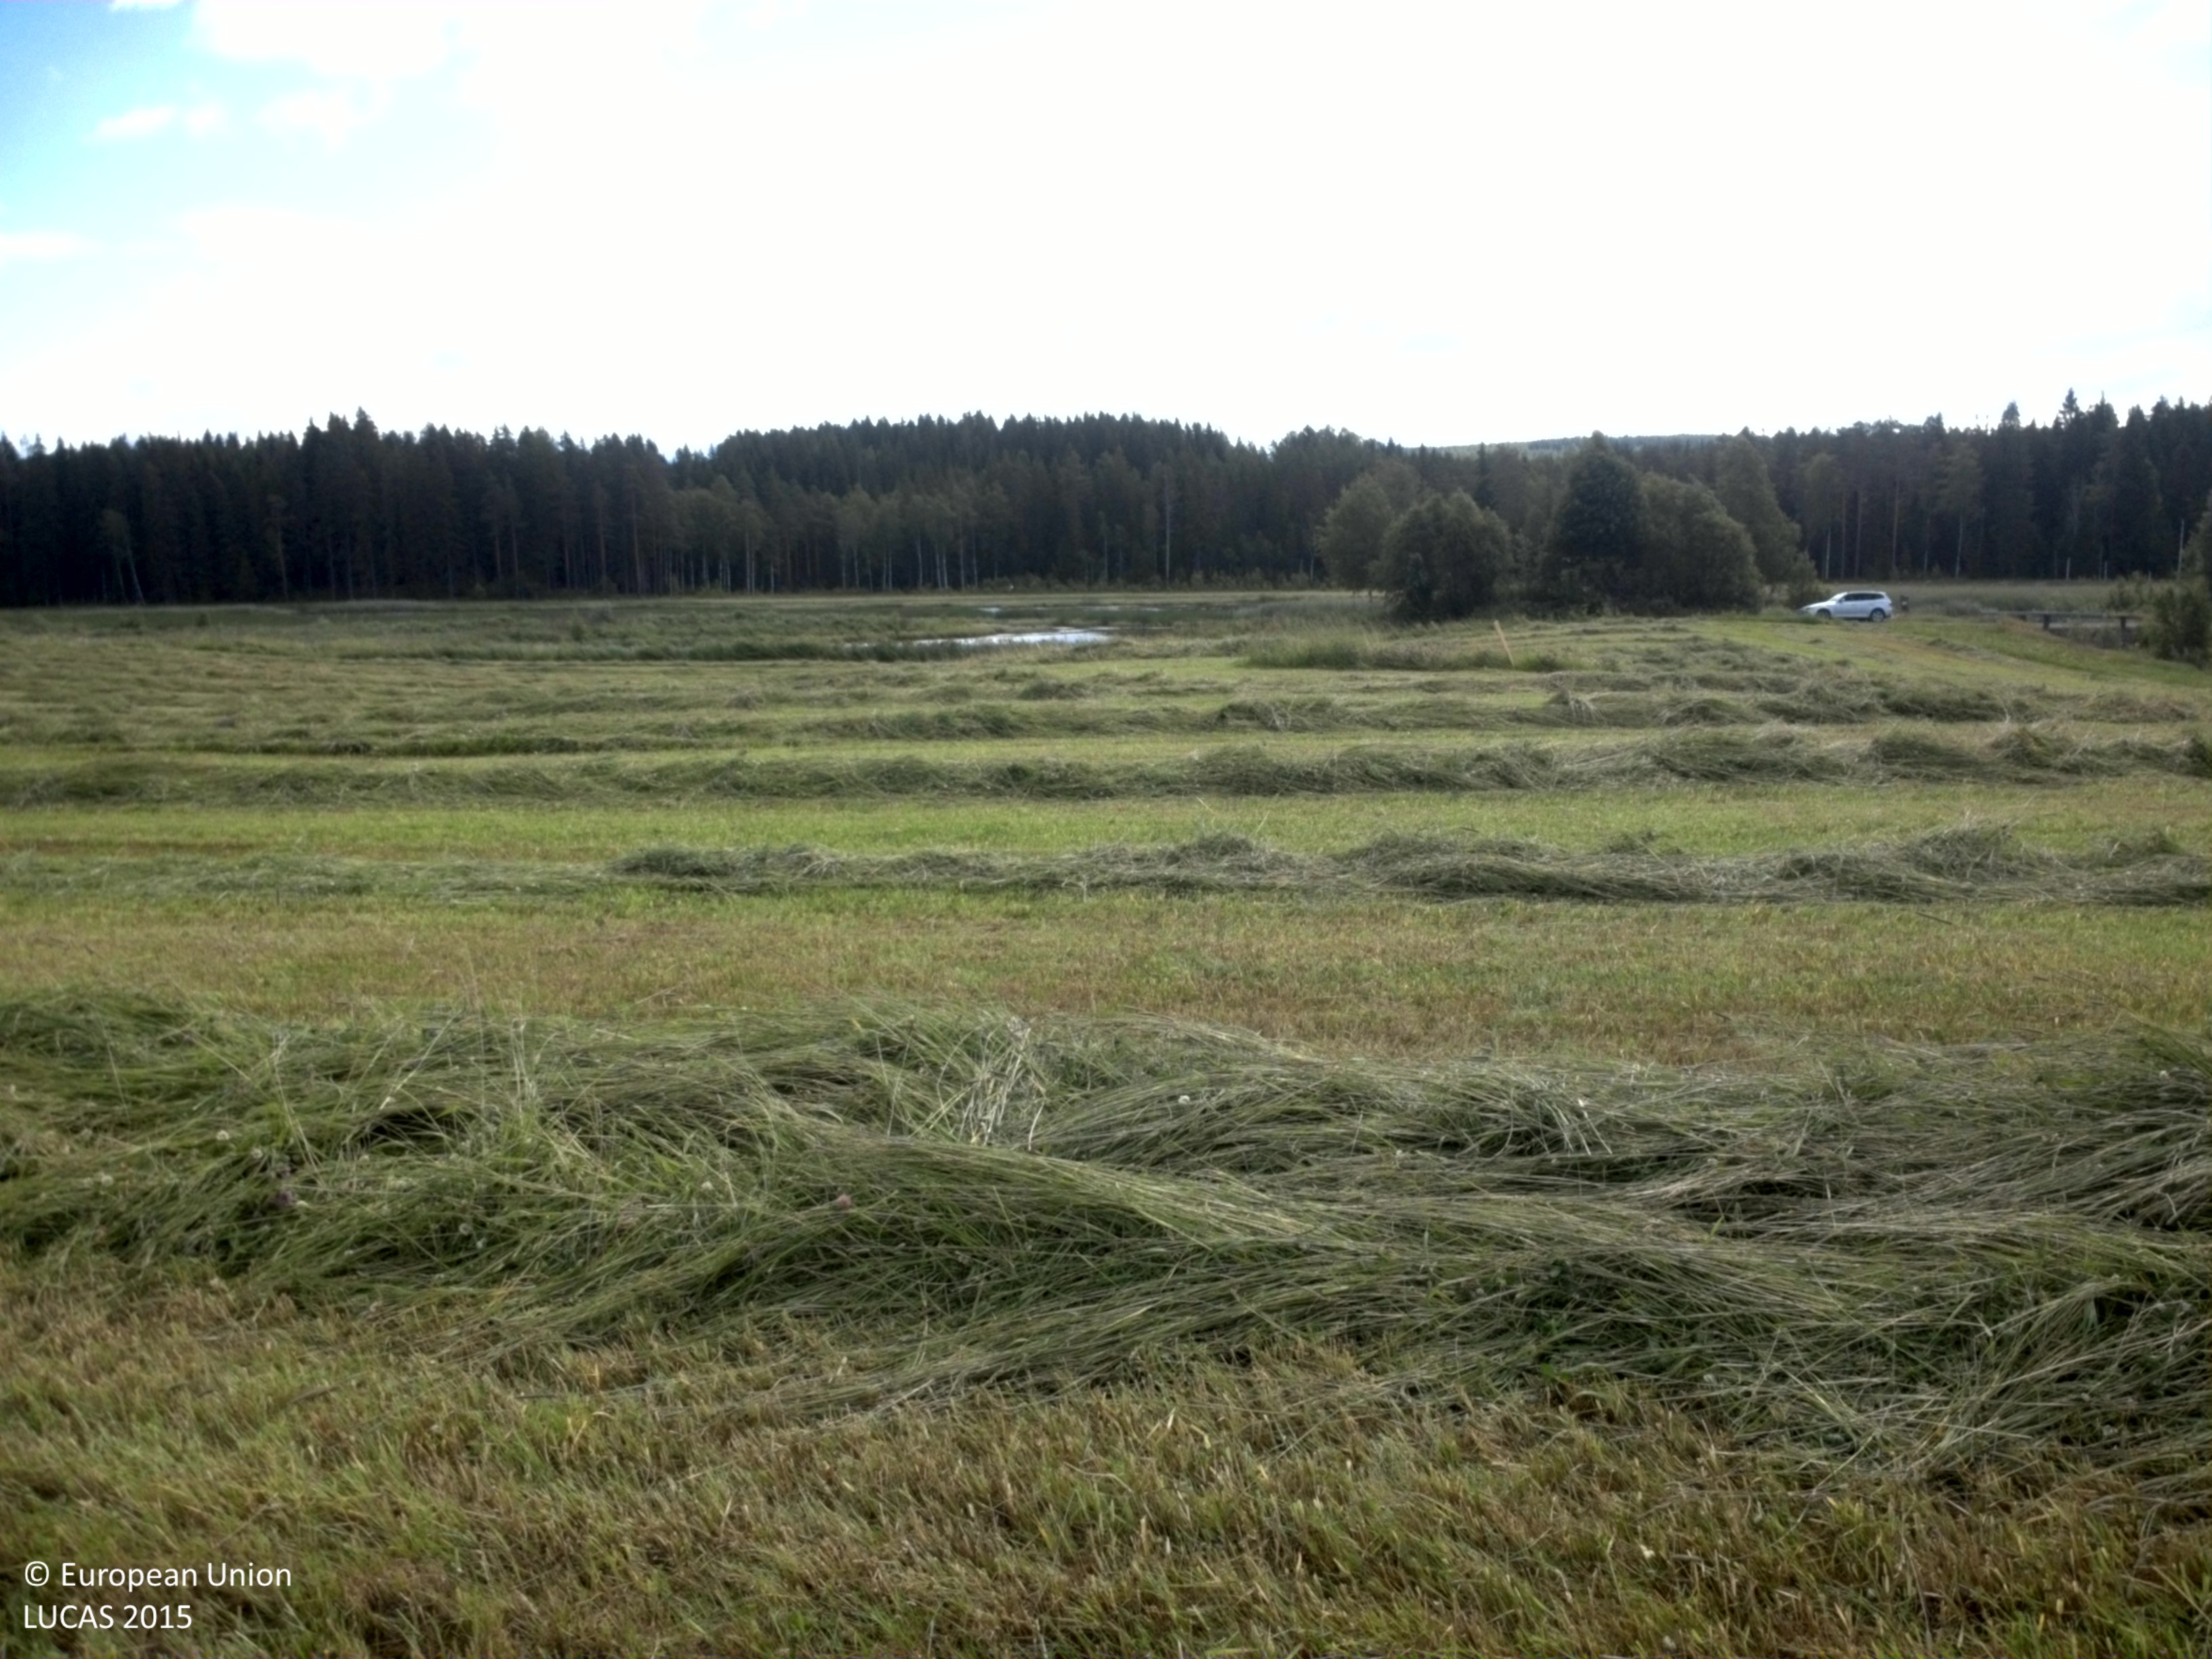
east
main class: Cropland
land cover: Other leguminous and mixtures for fodder
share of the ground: > 75 %
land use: Agriculture (excluding fallow land and kitchen gardens)
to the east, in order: Other leguminous and mixtures for fodder; Grass margins; Ditches and canals; Grass margins; Paved roads, cycling and walking lanes; Grass margins; Inland fresh water bodies; Spontaneously vegetated surfaces; Inland fresh water bodies; Inland marshes; Inland fresh water bodies; Inland marshes
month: July
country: SE
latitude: 59.8534
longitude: 12.4389
